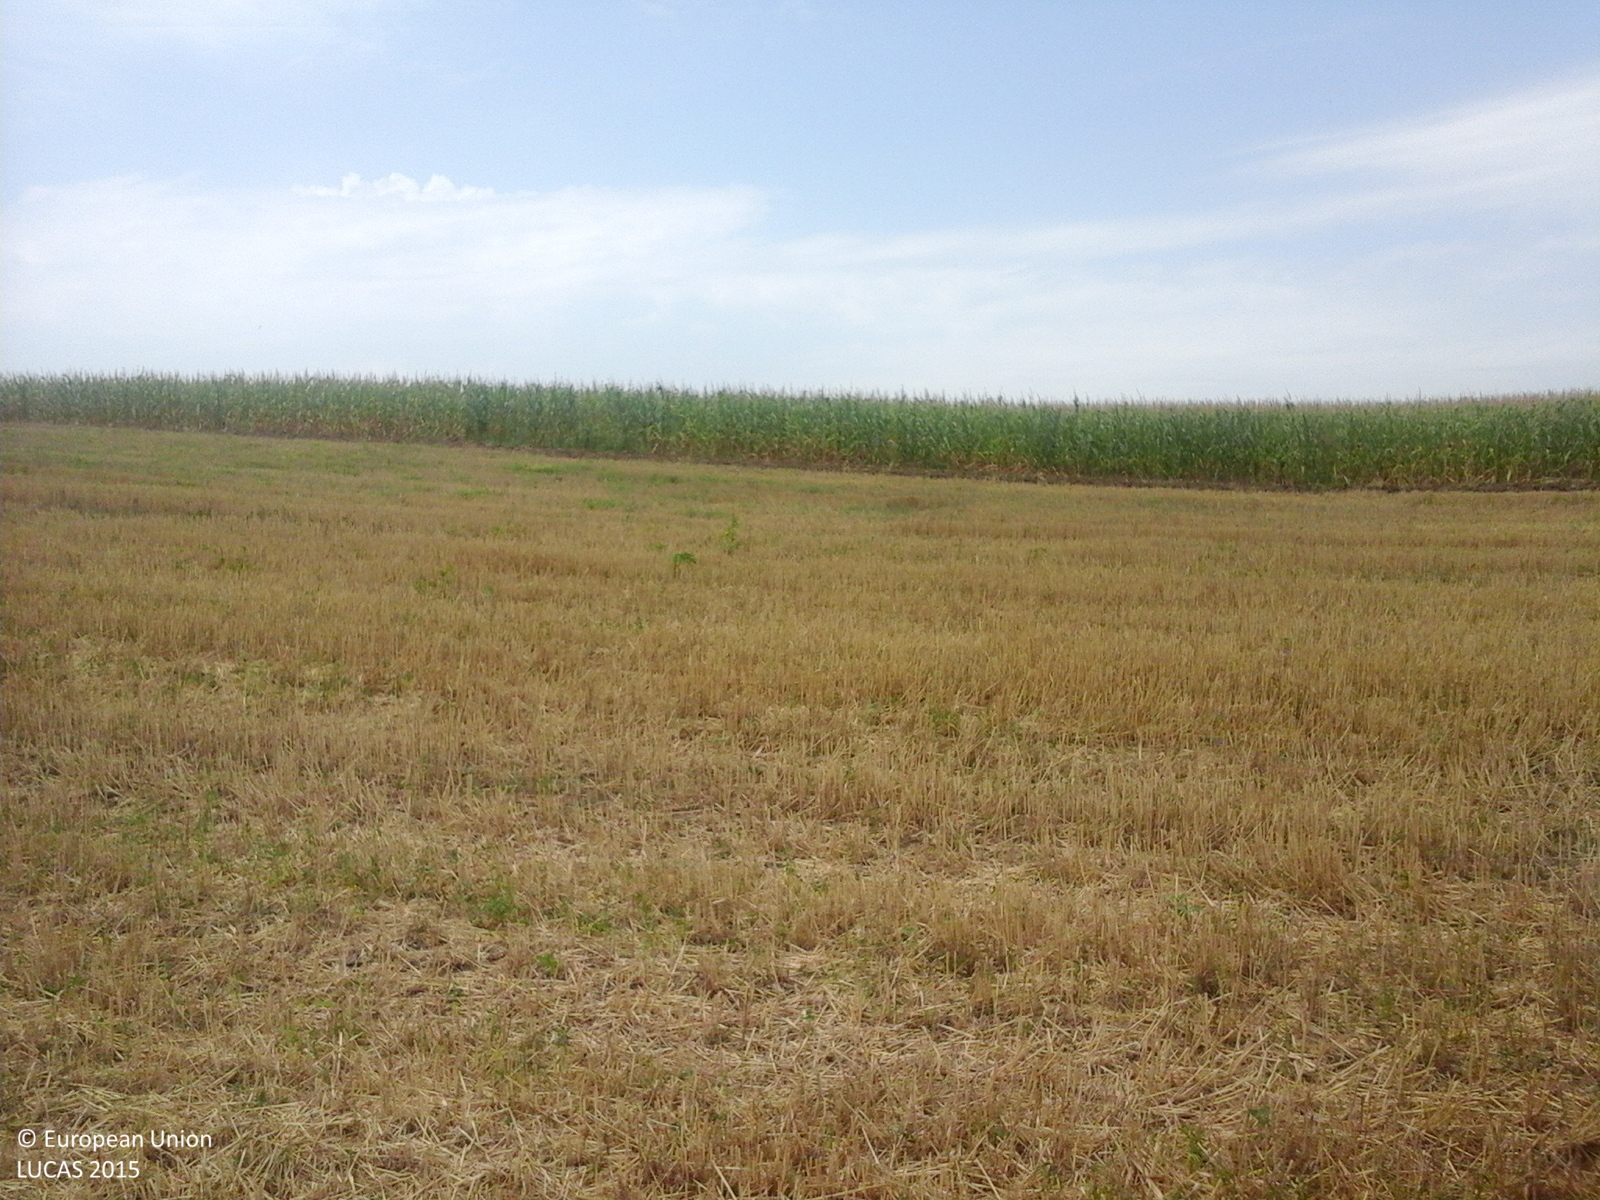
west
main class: Cropland
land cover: Common wheat
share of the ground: 25 - 50 %
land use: Agriculture (excluding fallow land and kitchen gardens)
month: August
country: RO
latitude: 43.9788
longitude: 27.7852
